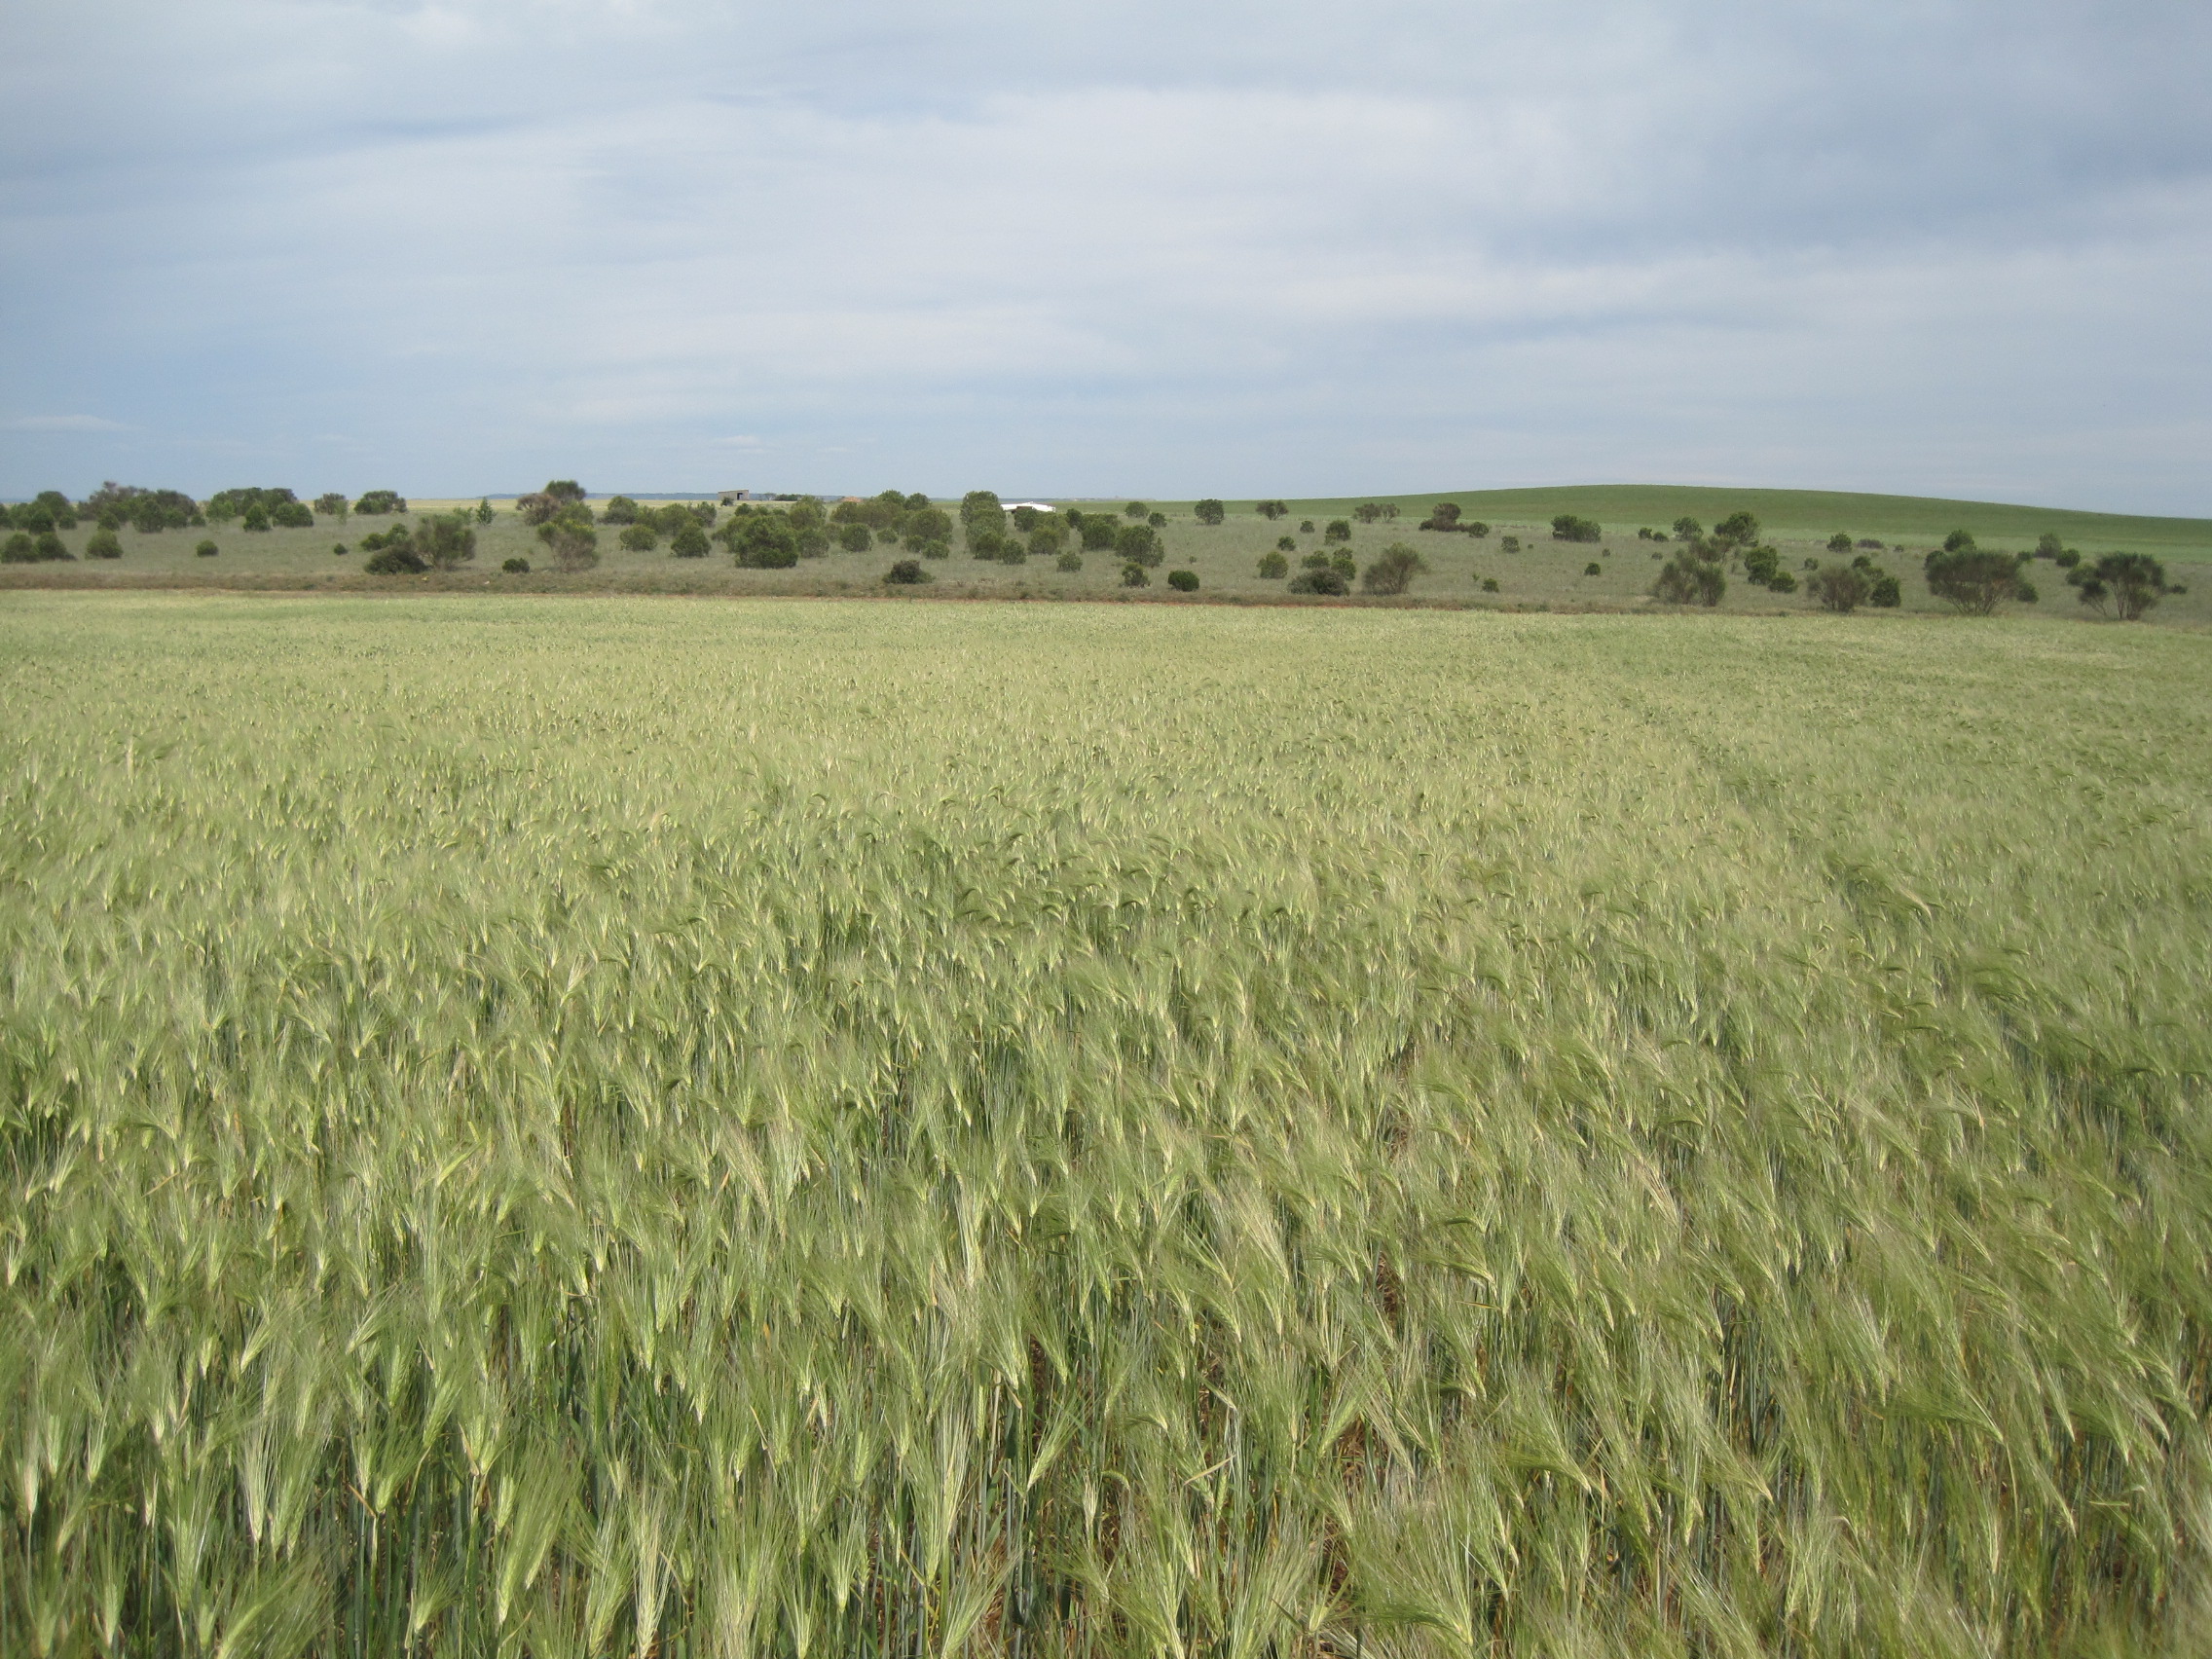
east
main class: Cropland
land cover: Barley
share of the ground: > 75 %
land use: Agriculture (excluding fallow land and kitchen gardens)
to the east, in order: Barley; Grass margins; Tracks; Grass margins; Pine dominated coniferous woodland; Grassland with sparse tree/shrub cover; Tracks; Grass margins; Dry pulses
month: May
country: ES
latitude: 41.7133
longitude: -5.3577
